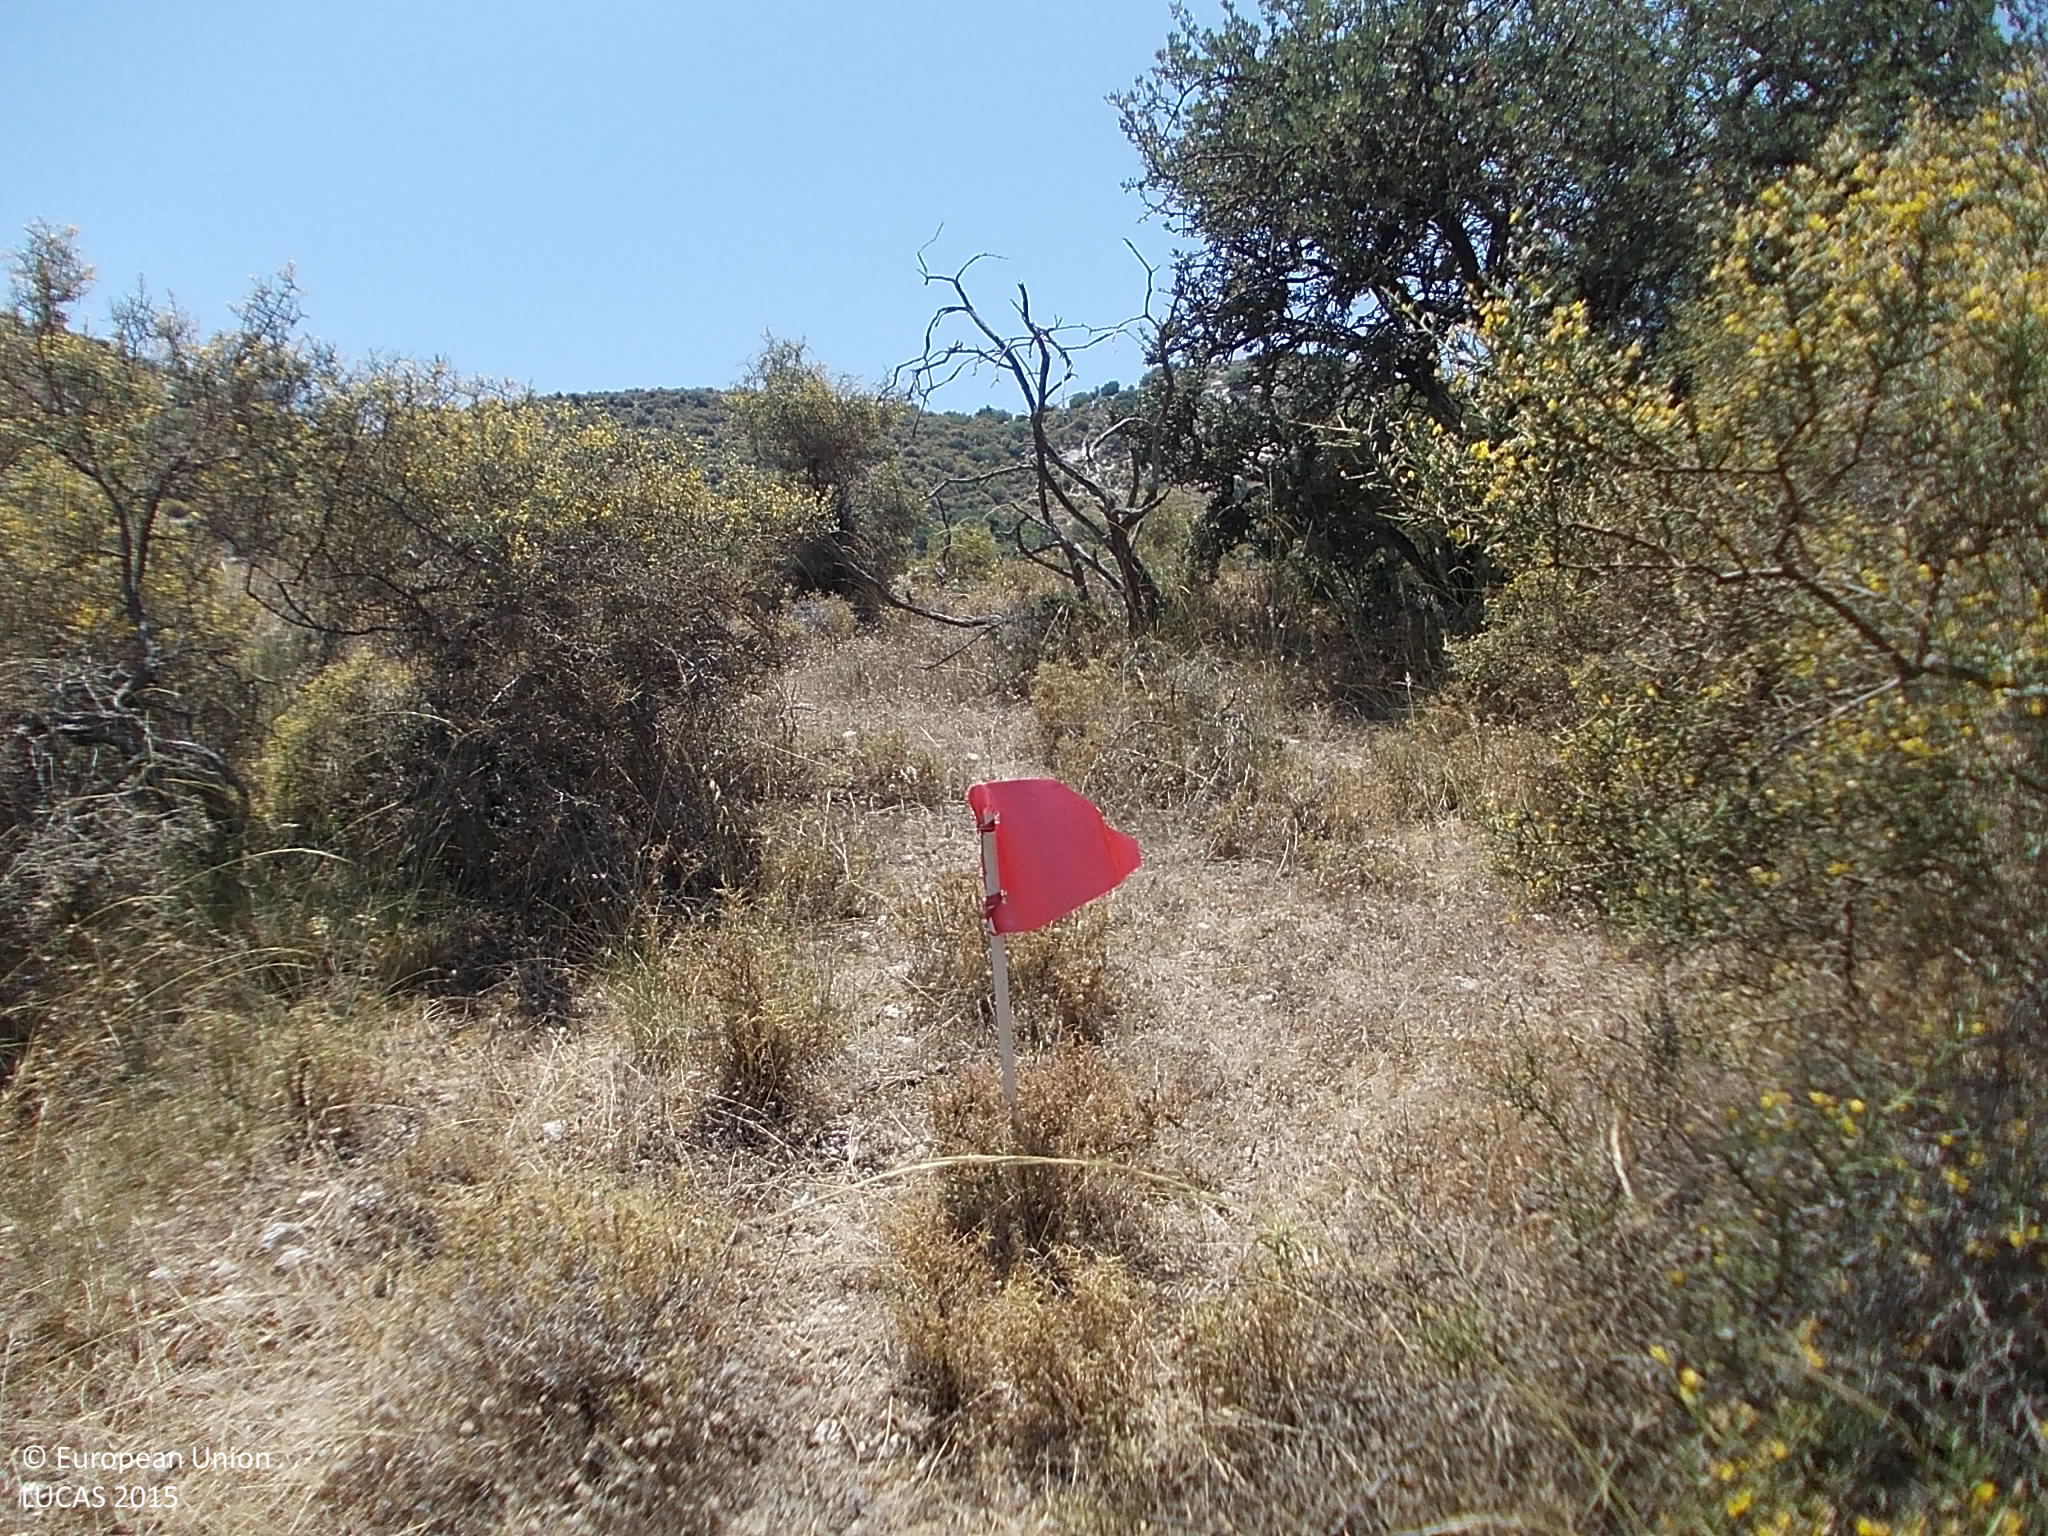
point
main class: Shrubland
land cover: Shrubland with sparse tree cover
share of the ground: 50 - 75 %
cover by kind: shrubs 65 %, herbaceous plants 15 %, unconsolidated bare surface 15 %, broadleaved forest trees 5 %
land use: Semi-natural and natural areas not in use
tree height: > 5 m
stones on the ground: 25 - 50 %
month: July
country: CY
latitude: 34.7370
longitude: 32.7077
